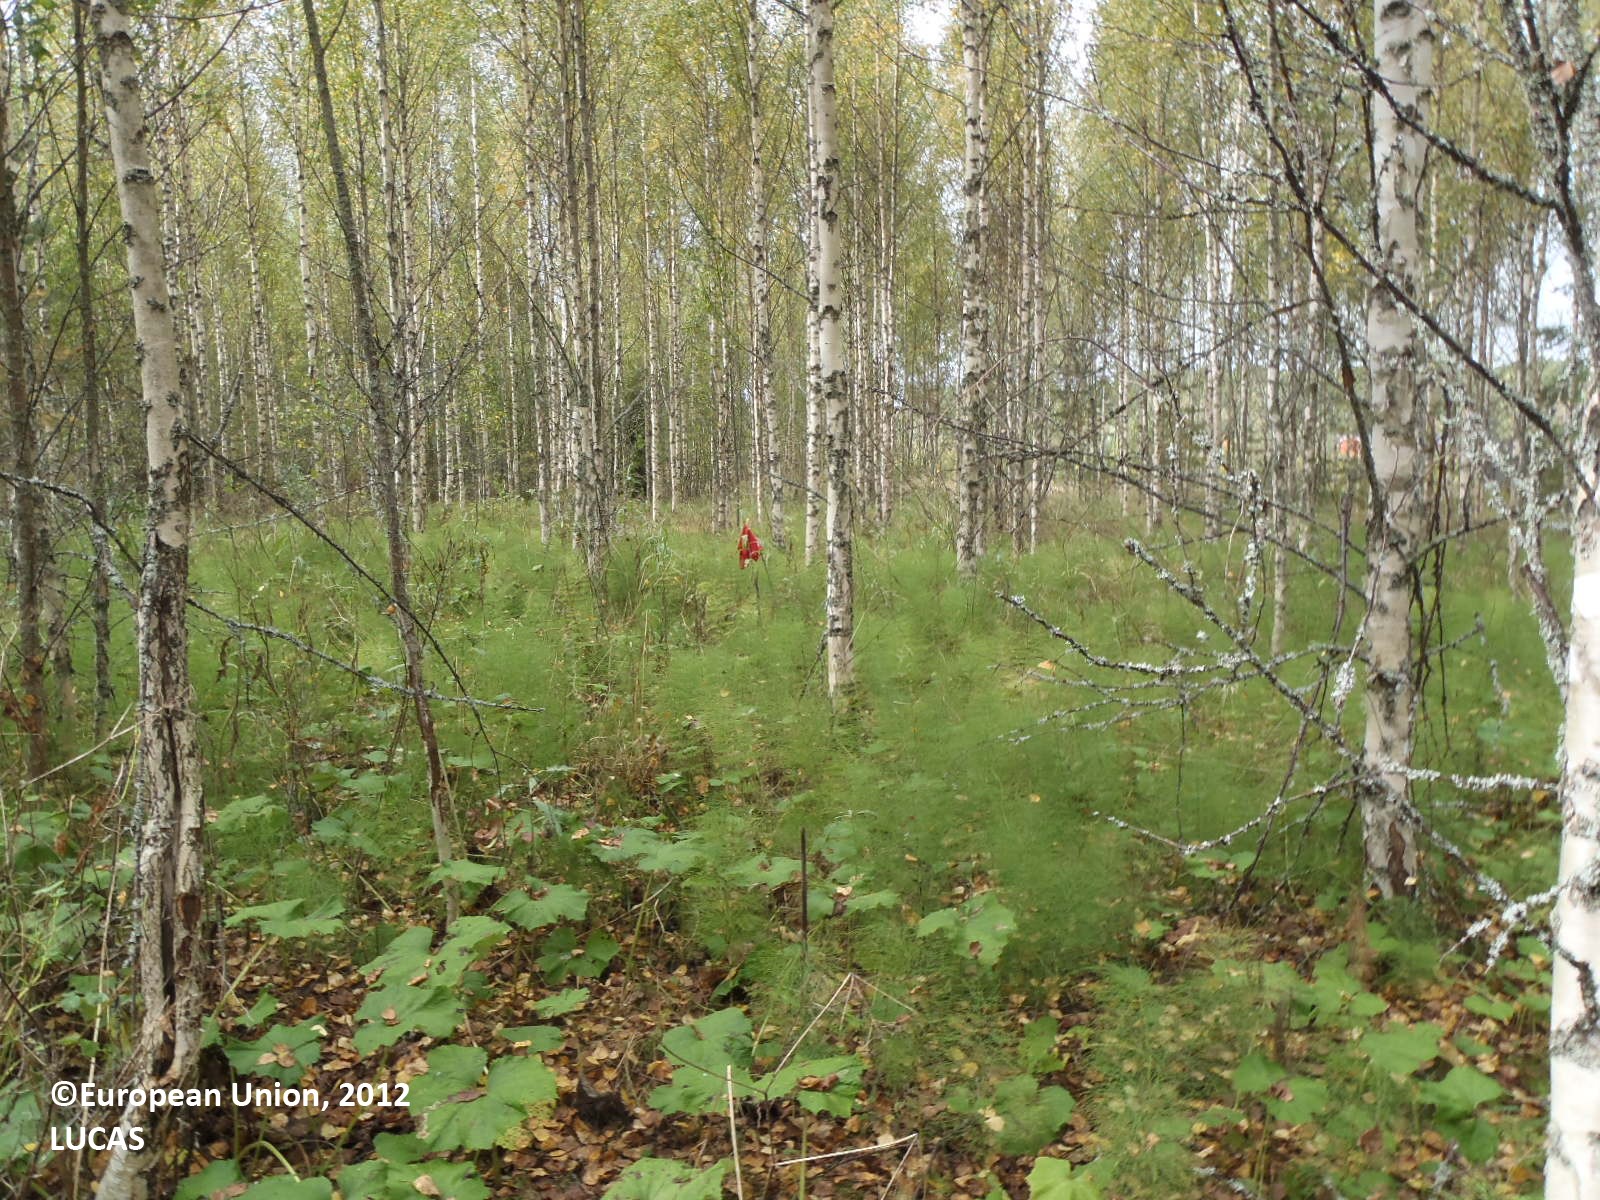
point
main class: Woodland
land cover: Broadleaved woodland
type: boreal forest
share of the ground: > 75 %
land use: Forestry
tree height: > 5 m
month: September
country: FI
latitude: 61.3206
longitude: 22.7138
